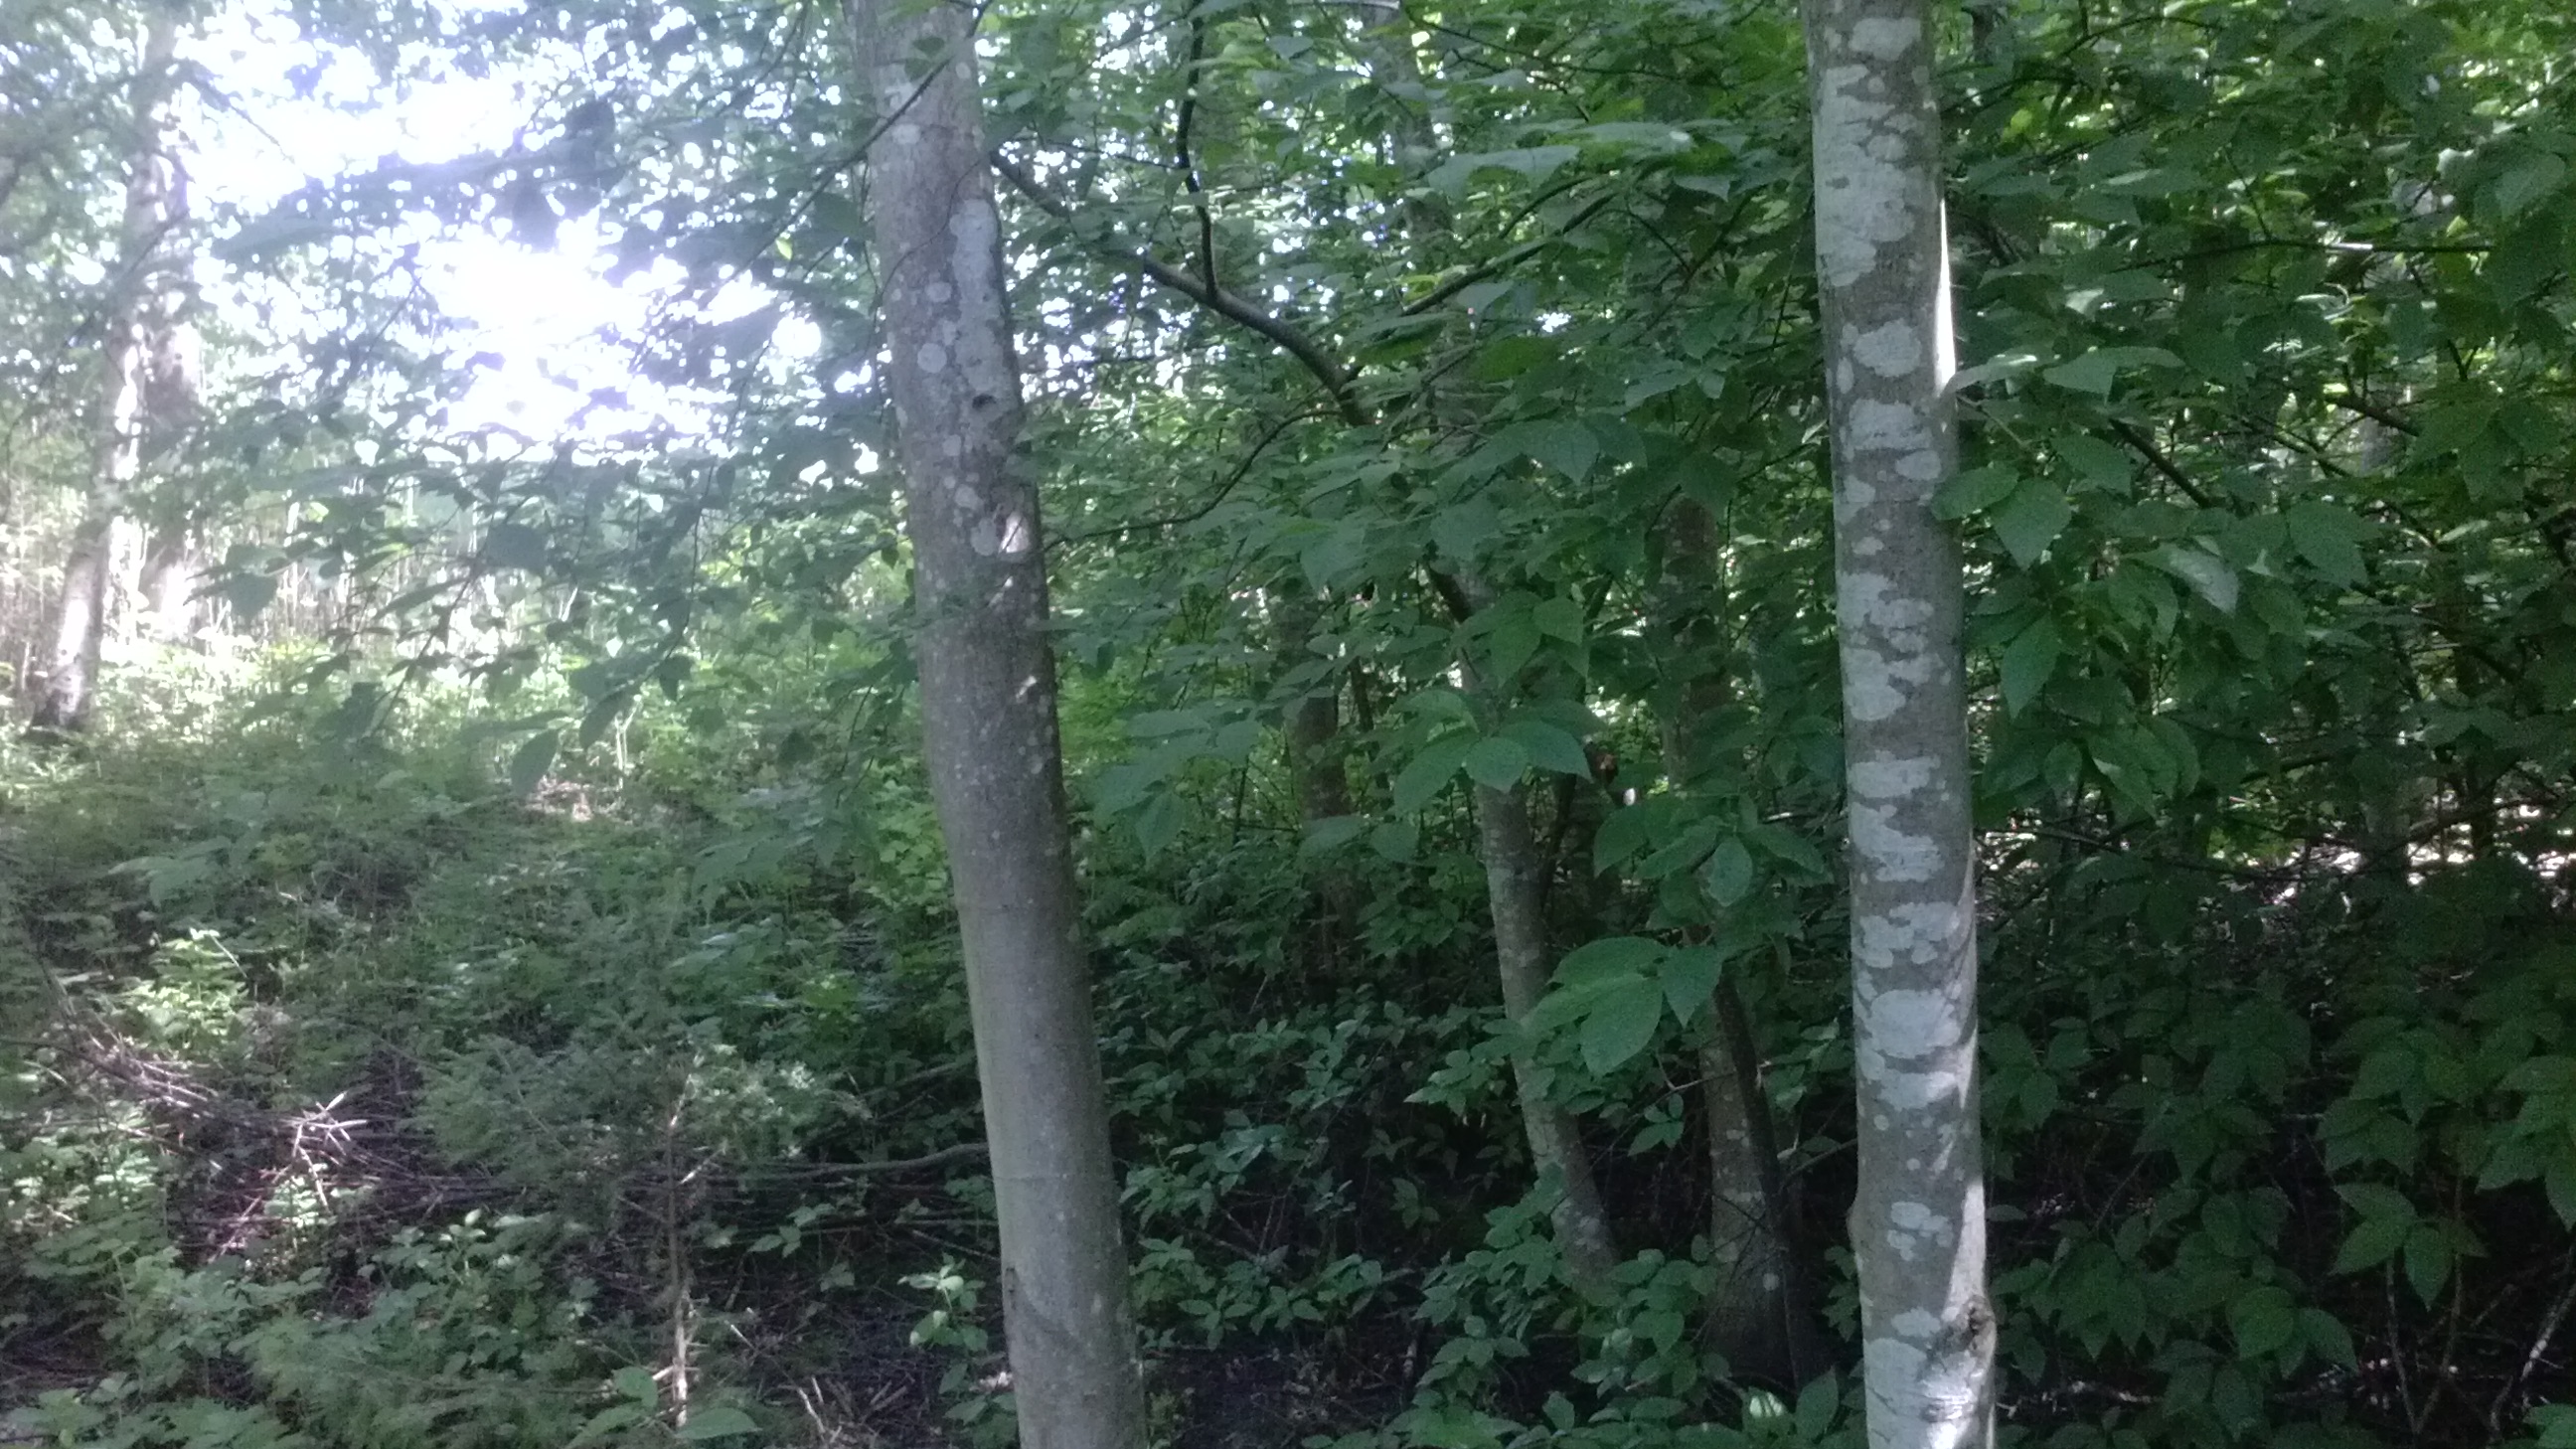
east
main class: Woodland
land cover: Broadleaved woodland
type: non-riverine alder, birch or aspen forest
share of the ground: > 75 %
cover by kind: broadleaved forest trees 80 %, shrubs 10 %, herbaceous plants 10 %
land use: Forestry
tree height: > 5 m
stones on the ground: < 10 %
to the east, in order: Broadleaved woodland; Grassland without tree/shrub cover; Tracks; Grass margins; Broadleaved woodland; Grassland without tree/shrub cover; Broadleaved woodland
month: May
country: LV
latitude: 56.2920
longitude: 27.1497
